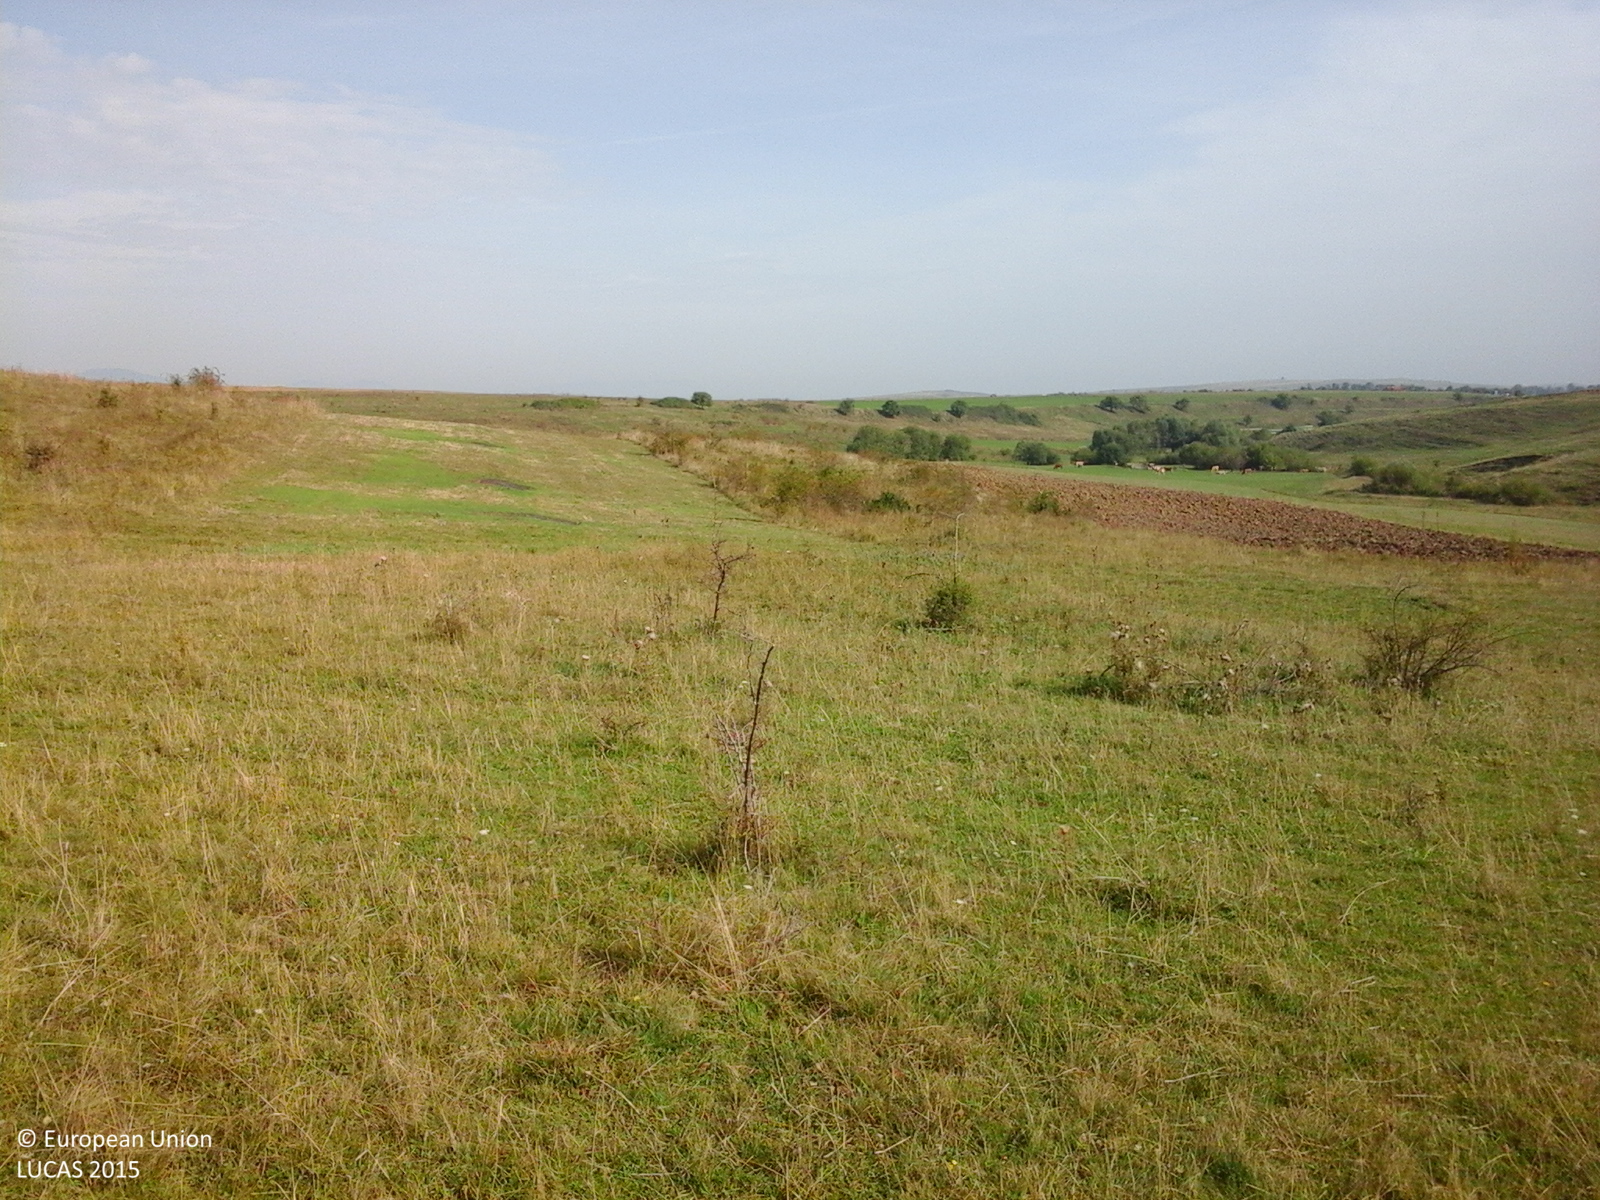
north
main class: Grassland
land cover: Grassland with sparse tree/shrub cover
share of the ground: > 75 %
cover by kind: herbaceous plants 90 %, broadleaved forest trees 5 %, shrubs 5 %
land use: Agriculture (excluding fallow land and kitchen gardens)
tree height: < 5 m
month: September
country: RO
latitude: 46.8155
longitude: 22.9702
